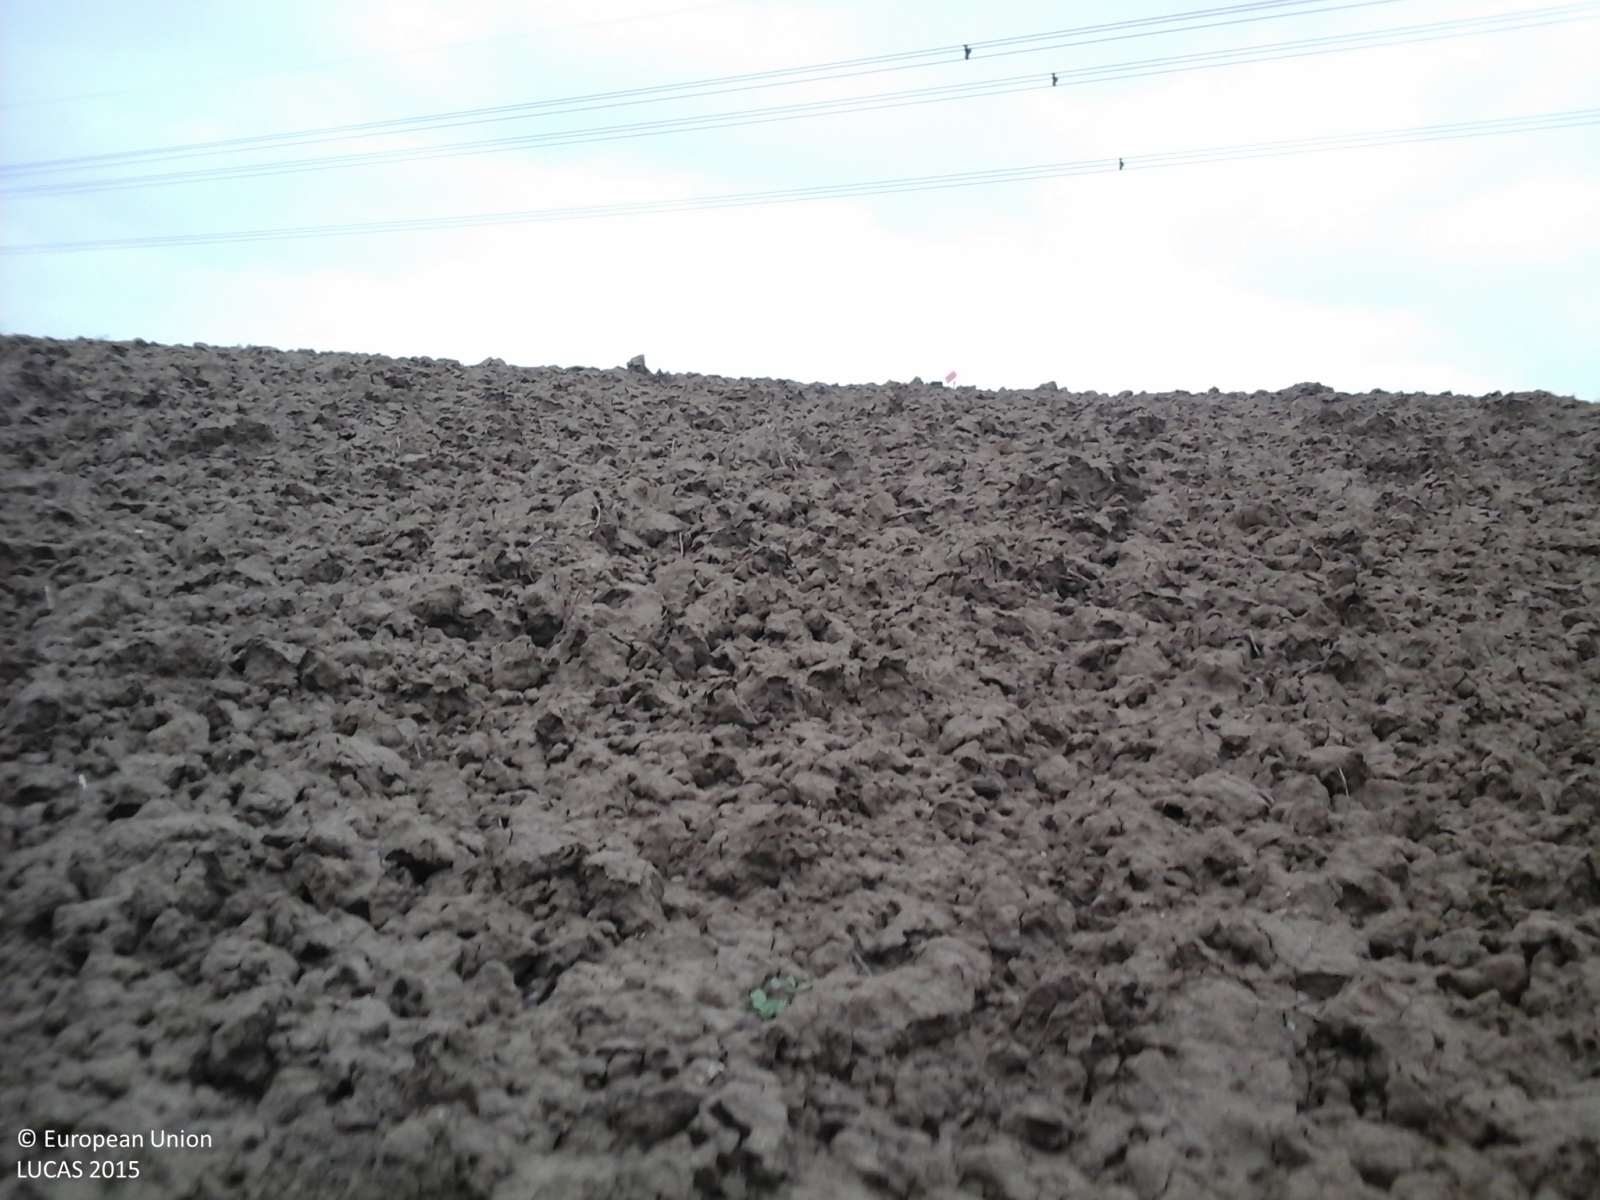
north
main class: Cropland
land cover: Durum wheat
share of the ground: < 10 %
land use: Agriculture (excluding fallow land and kitchen gardens)
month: October
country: IT
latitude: 43.6316
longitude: 13.2519
